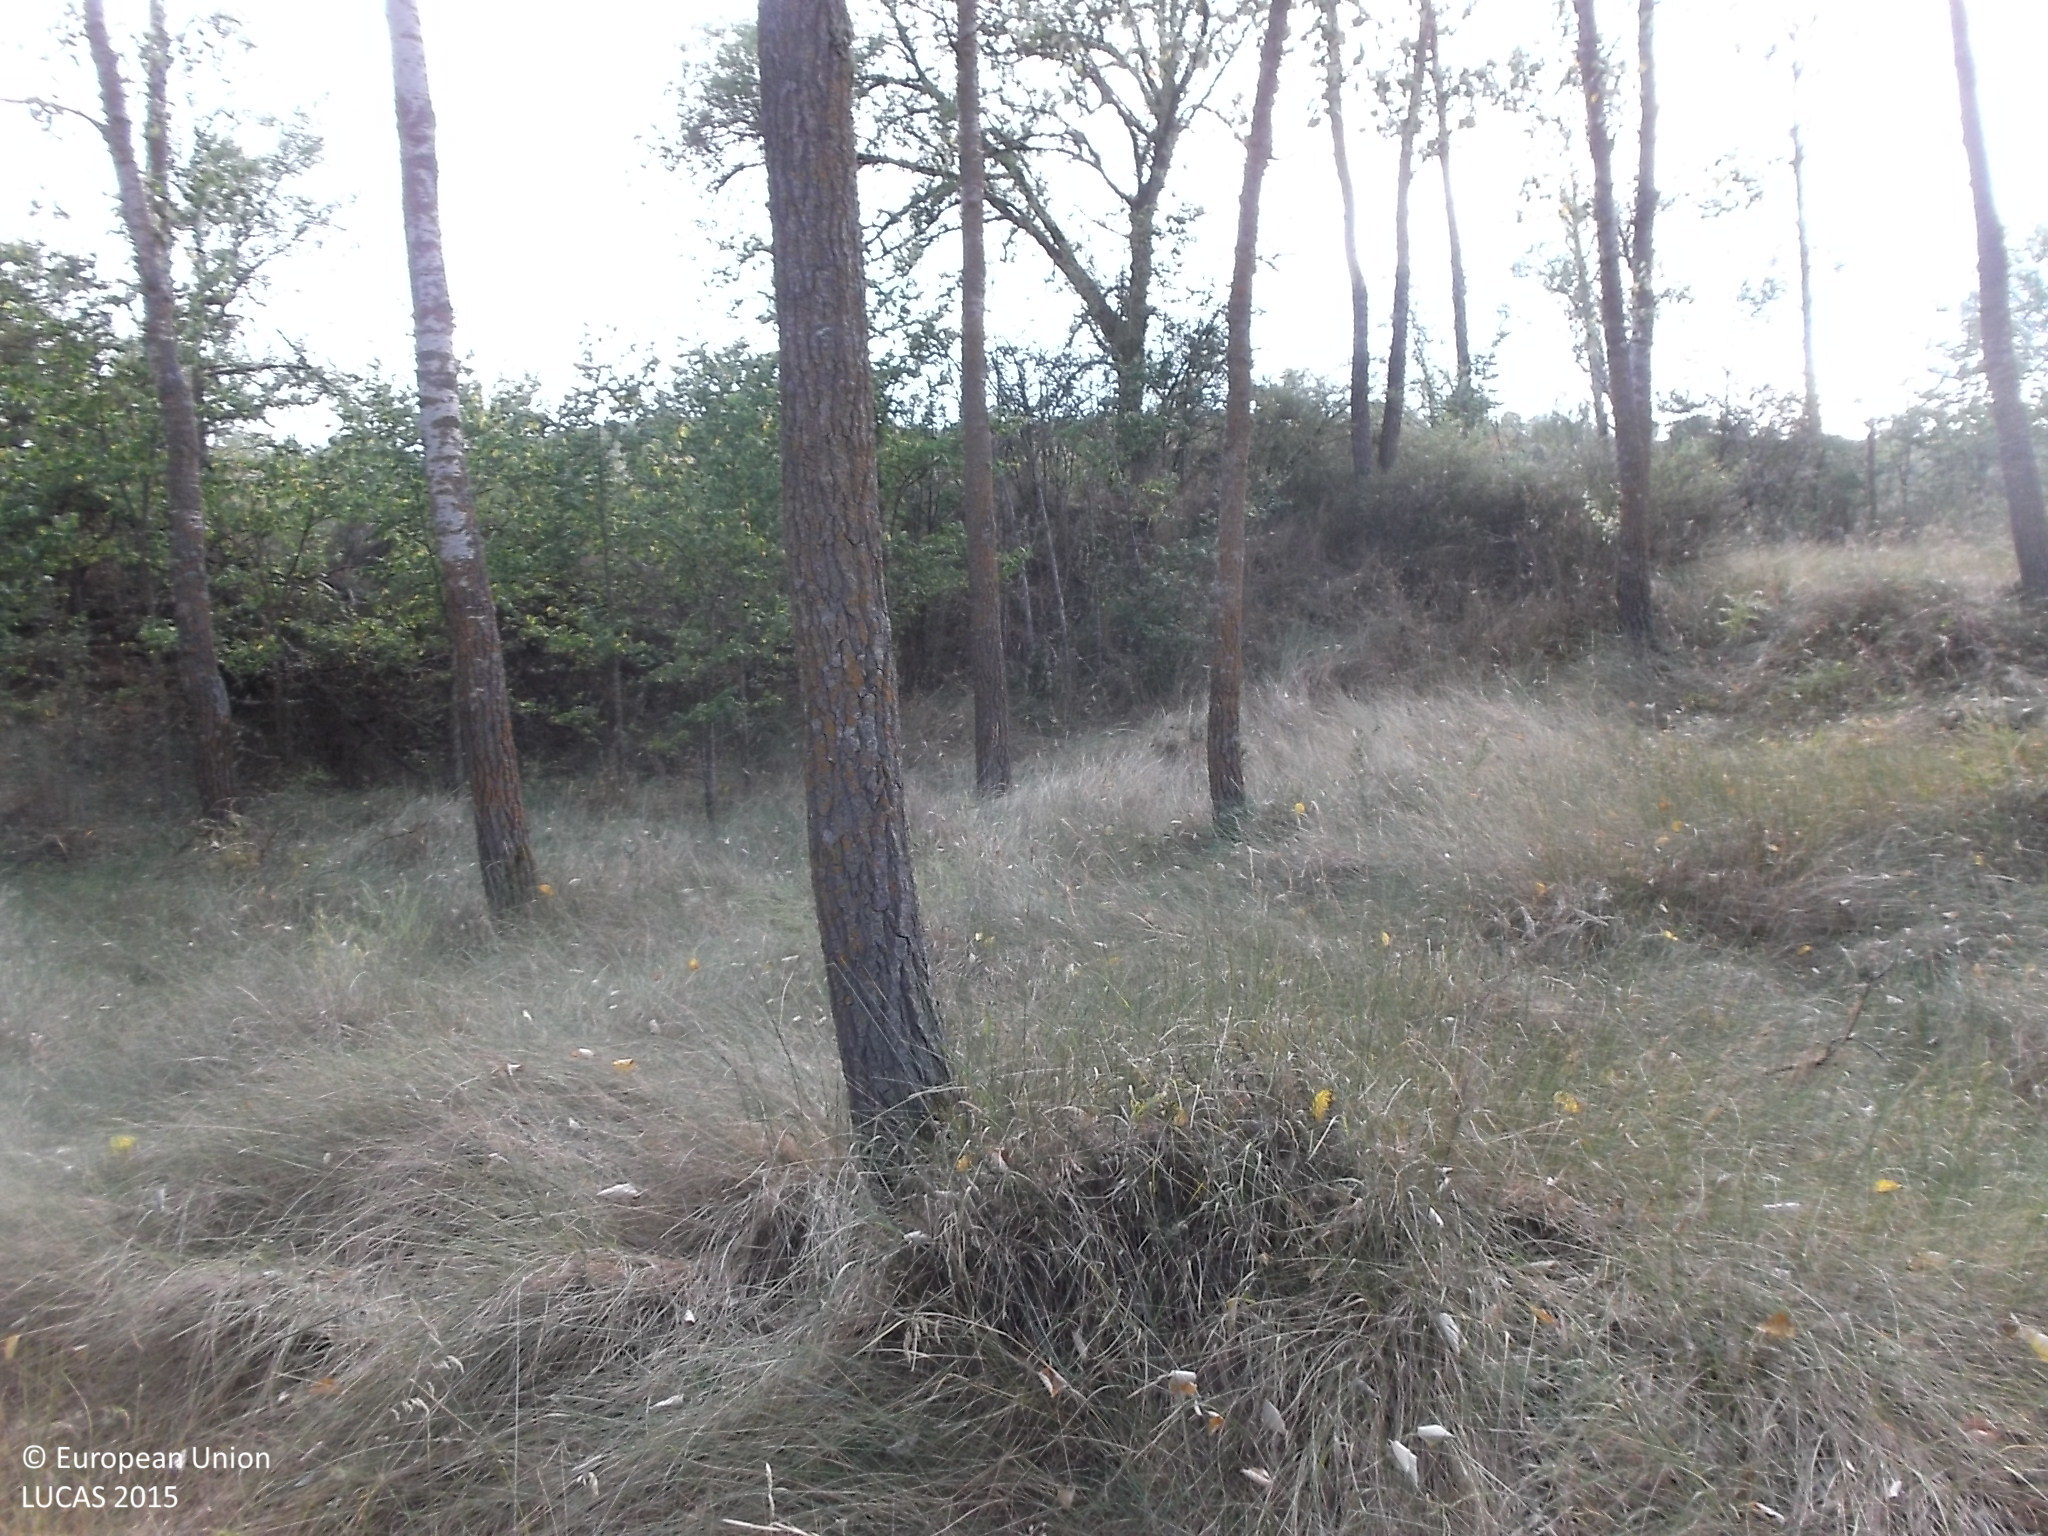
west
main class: Woodland
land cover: Broadleaved woodland
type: thermophilous deciduous forest
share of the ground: 50 - 75 %
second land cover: Grassland without tree/shrub cover
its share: 25 - 50 %
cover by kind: broadleaved forest trees 60 %, herbaceous plants 40 %
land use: Forestry
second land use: Agriculture (excluding fallow land and kitchen gardens)
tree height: > 5 m
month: July
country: ES
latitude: 41.4828
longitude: -5.8858
